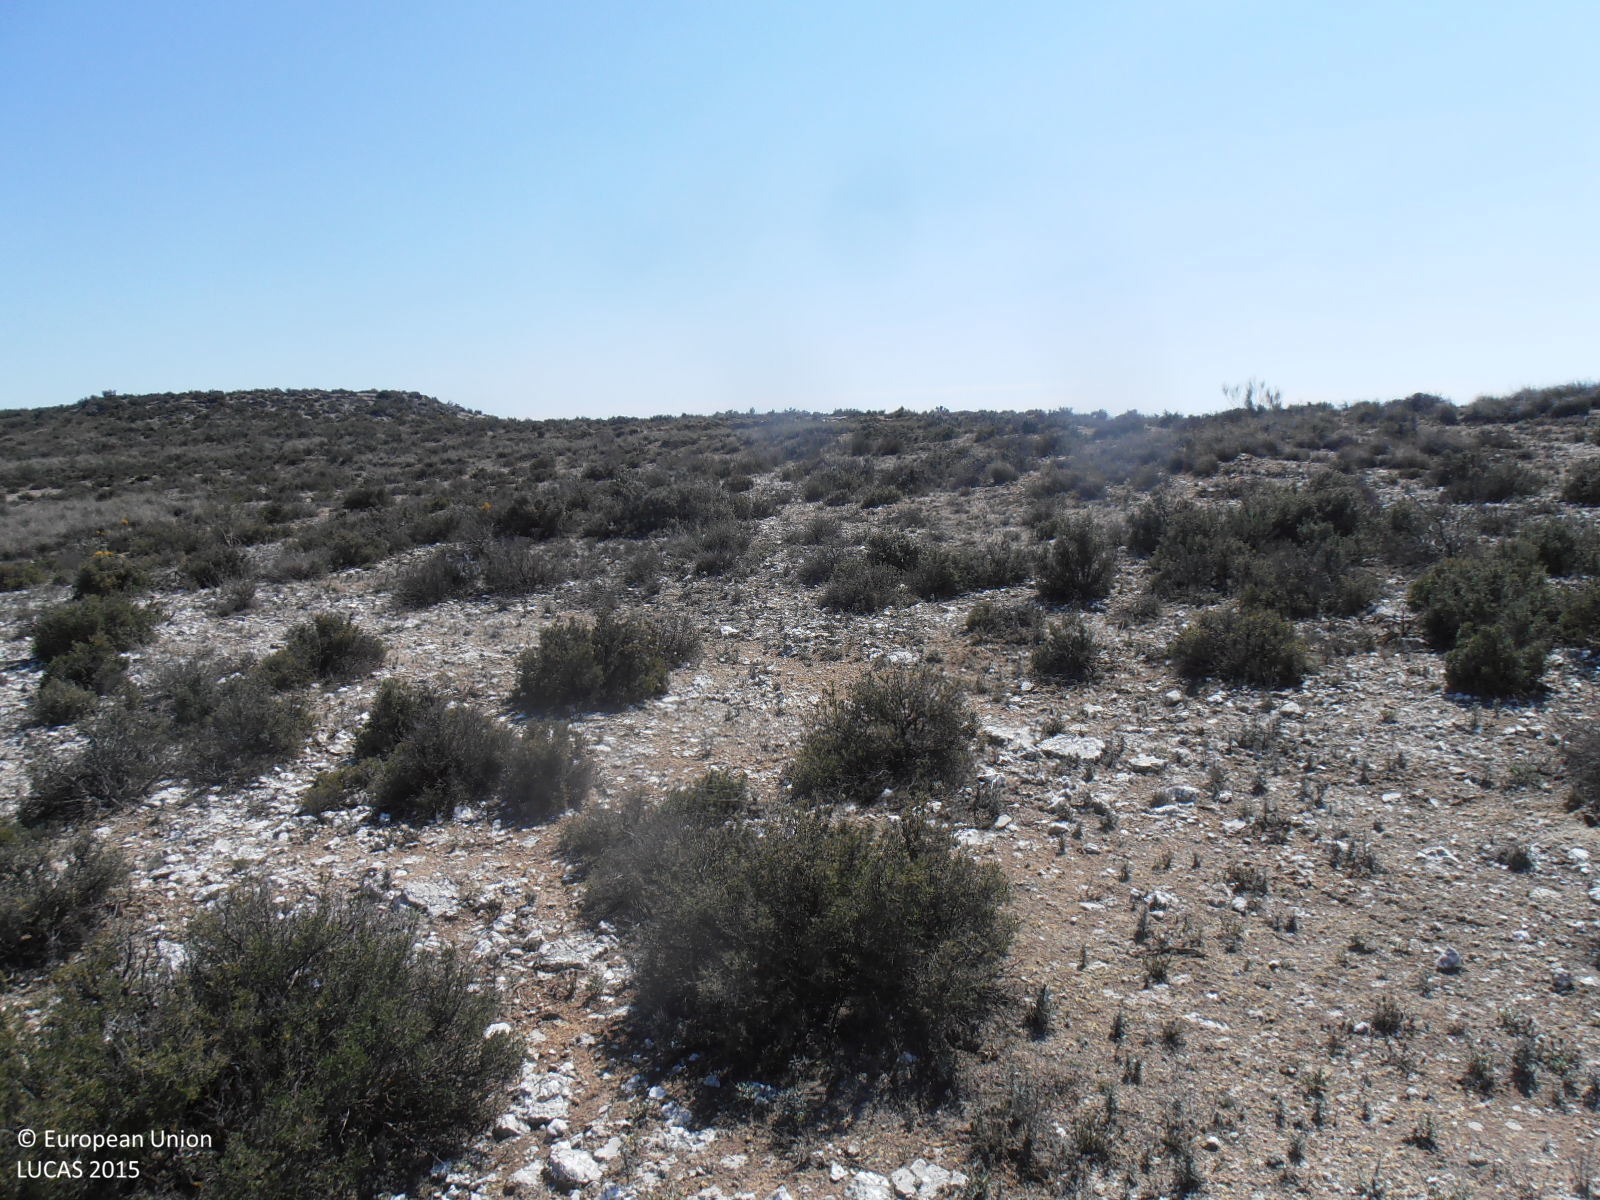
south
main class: Shrubland
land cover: Shrubland without tree cover
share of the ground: > 75 %
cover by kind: consolidated bare surface 70 %, shrubs 30 %
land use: Semi-natural and natural areas not in use
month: April
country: ES
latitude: 41.5825
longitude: -0.9730
